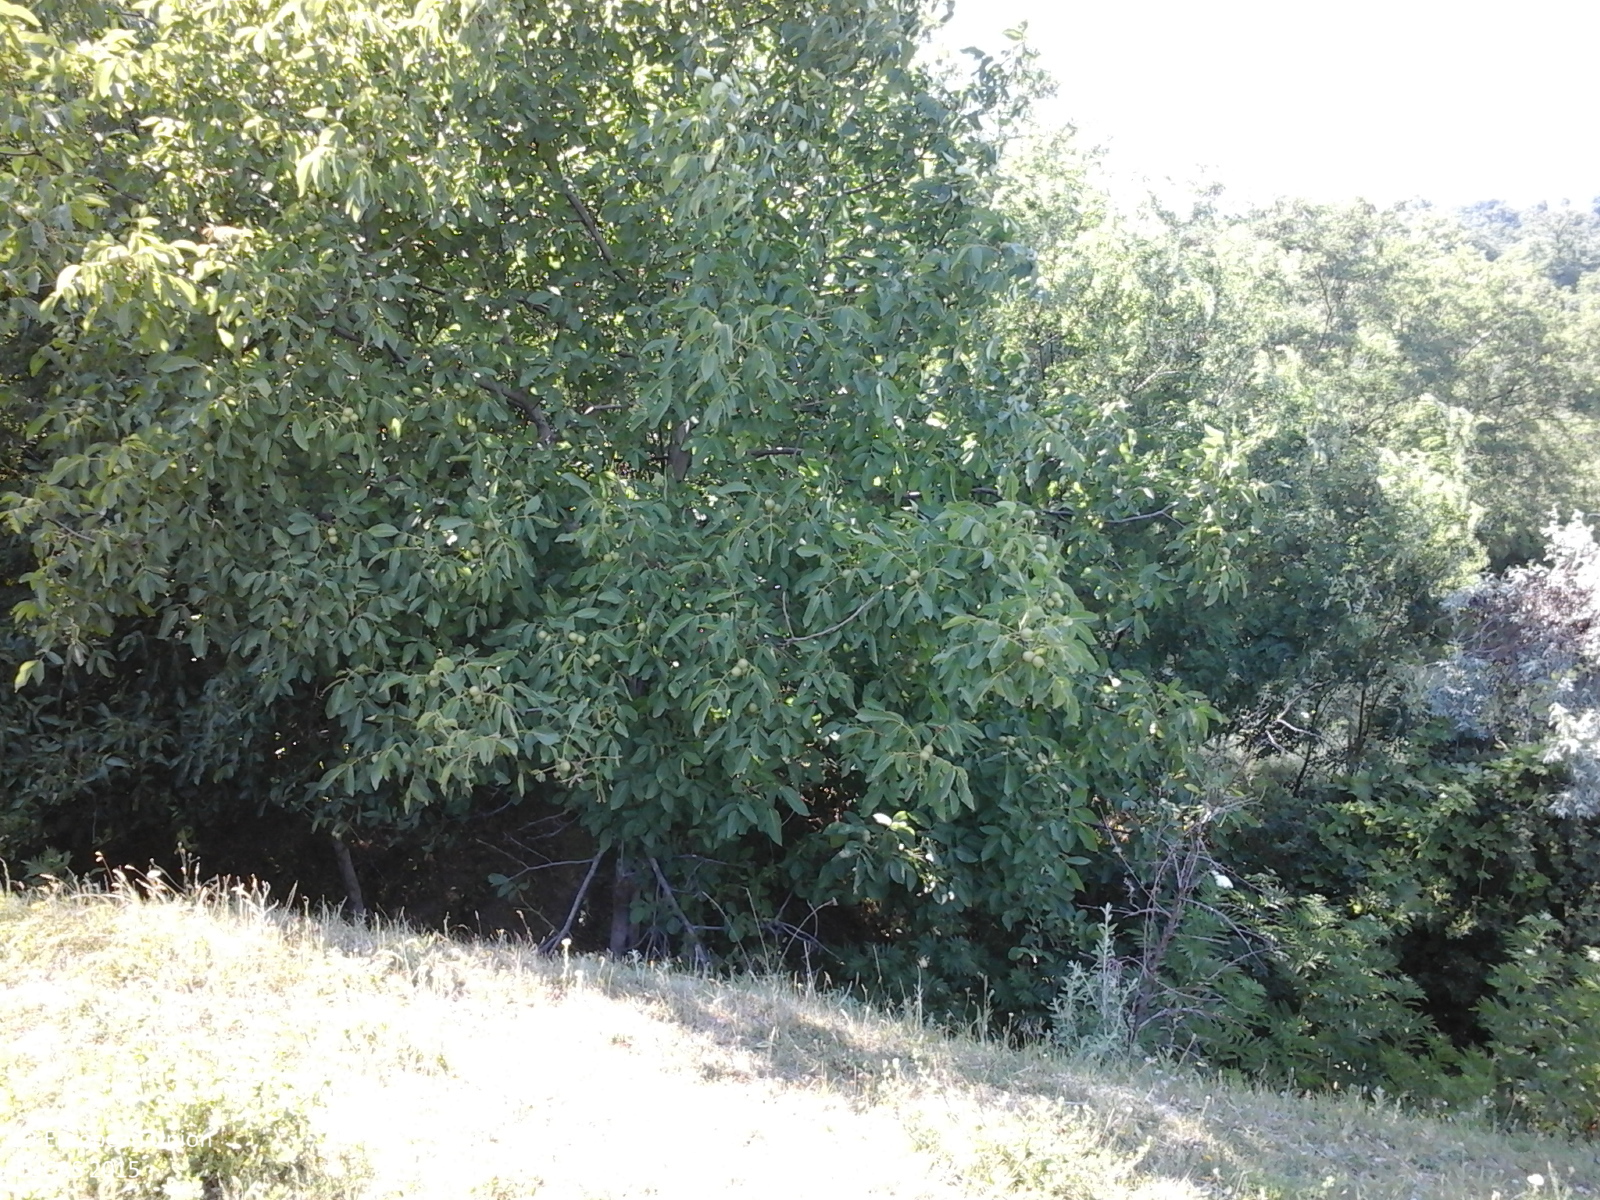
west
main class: Grassland
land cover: Grassland without tree/shrub cover
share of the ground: > 75 %
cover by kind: herbaceous plants 100 %
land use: Agriculture (excluding fallow land and kitchen gardens)
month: June
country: RO
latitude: 46.8533
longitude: 28.0057
